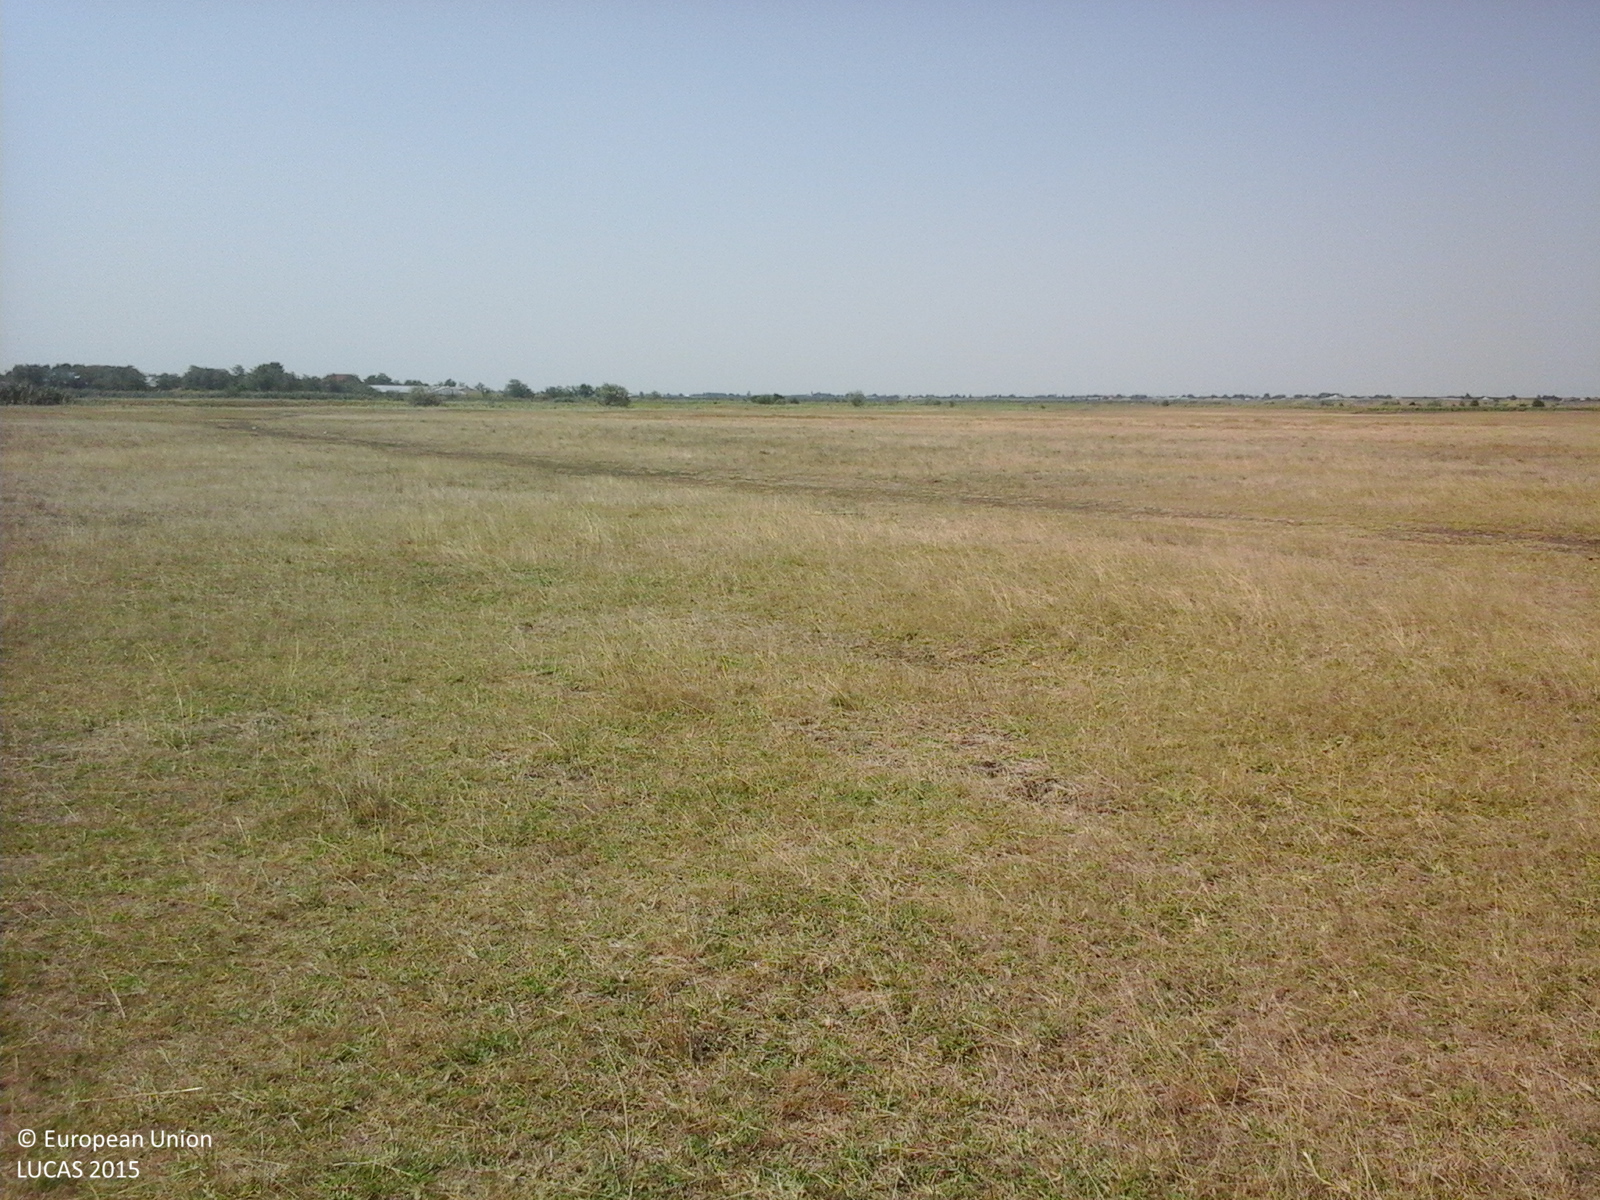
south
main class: Cropland
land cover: Temporary grasslands
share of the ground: > 75 %
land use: Agriculture (excluding fallow land and kitchen gardens)
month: August
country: RO
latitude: 45.7287
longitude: 27.4633
